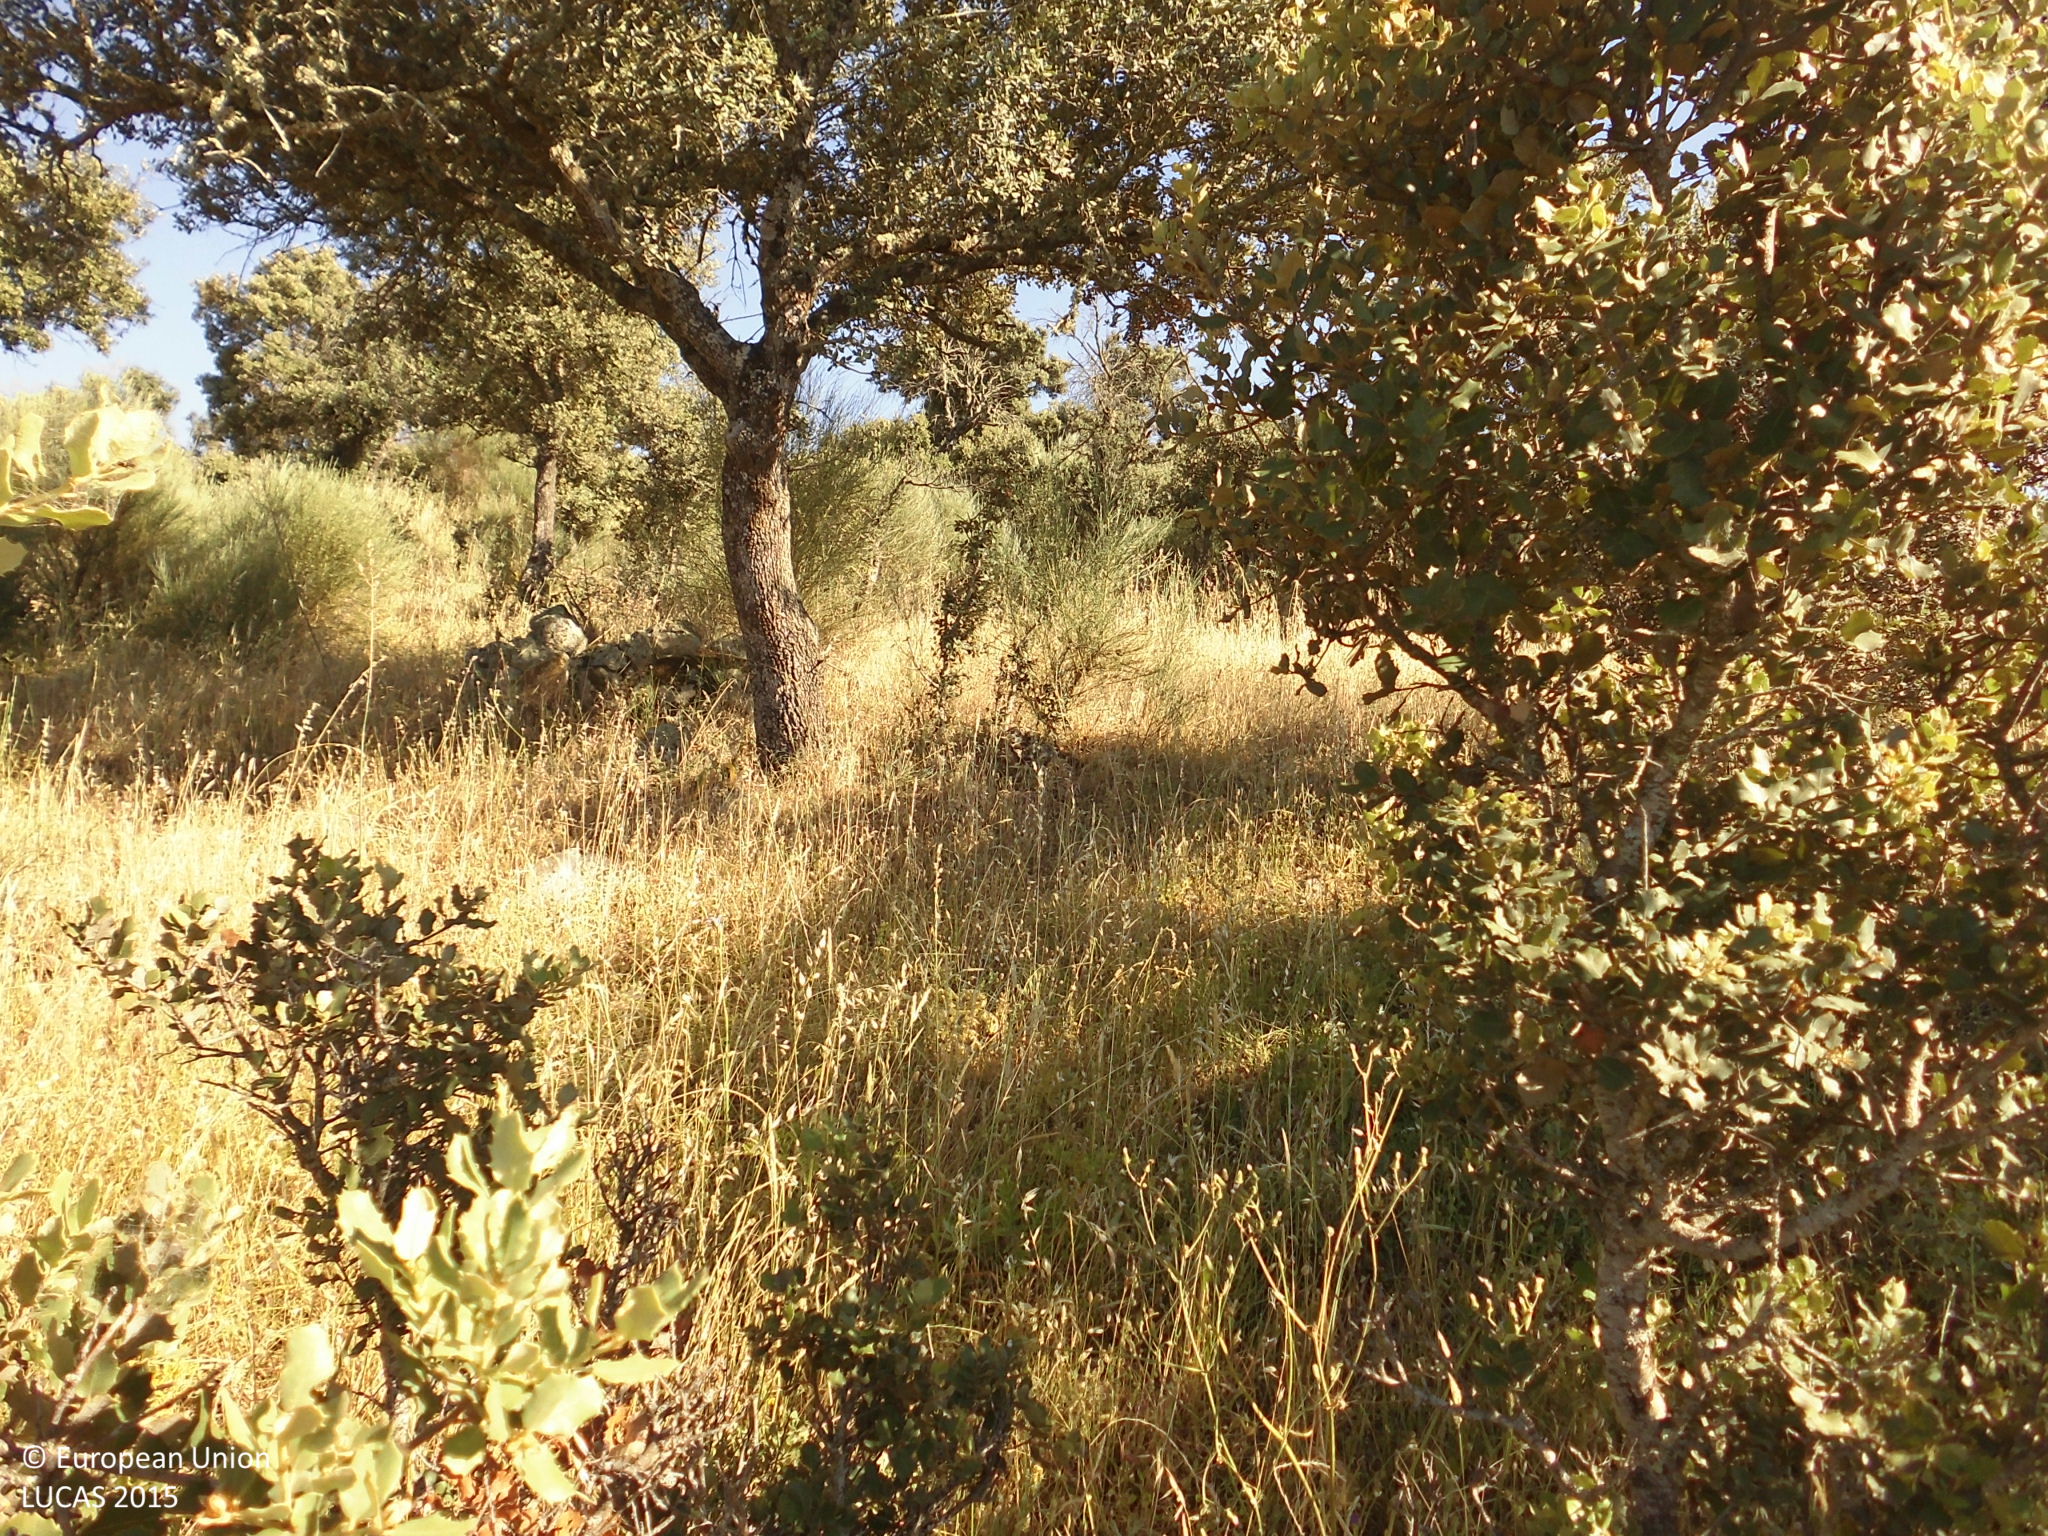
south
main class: Woodland
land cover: Broadleaved woodland
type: broadleaved evergreen forest
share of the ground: 25 - 50 %
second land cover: Grassland without tree/shrub cover
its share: > 75 %
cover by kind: herbaceous plants 50 %, broadleaved forest trees 30 %, shrubs 20 %
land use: Forestry
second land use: Agriculture (excluding fallow land and kitchen gardens)
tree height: > 5 m
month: May
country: ES
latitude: 39.4318
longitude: -6.0585
